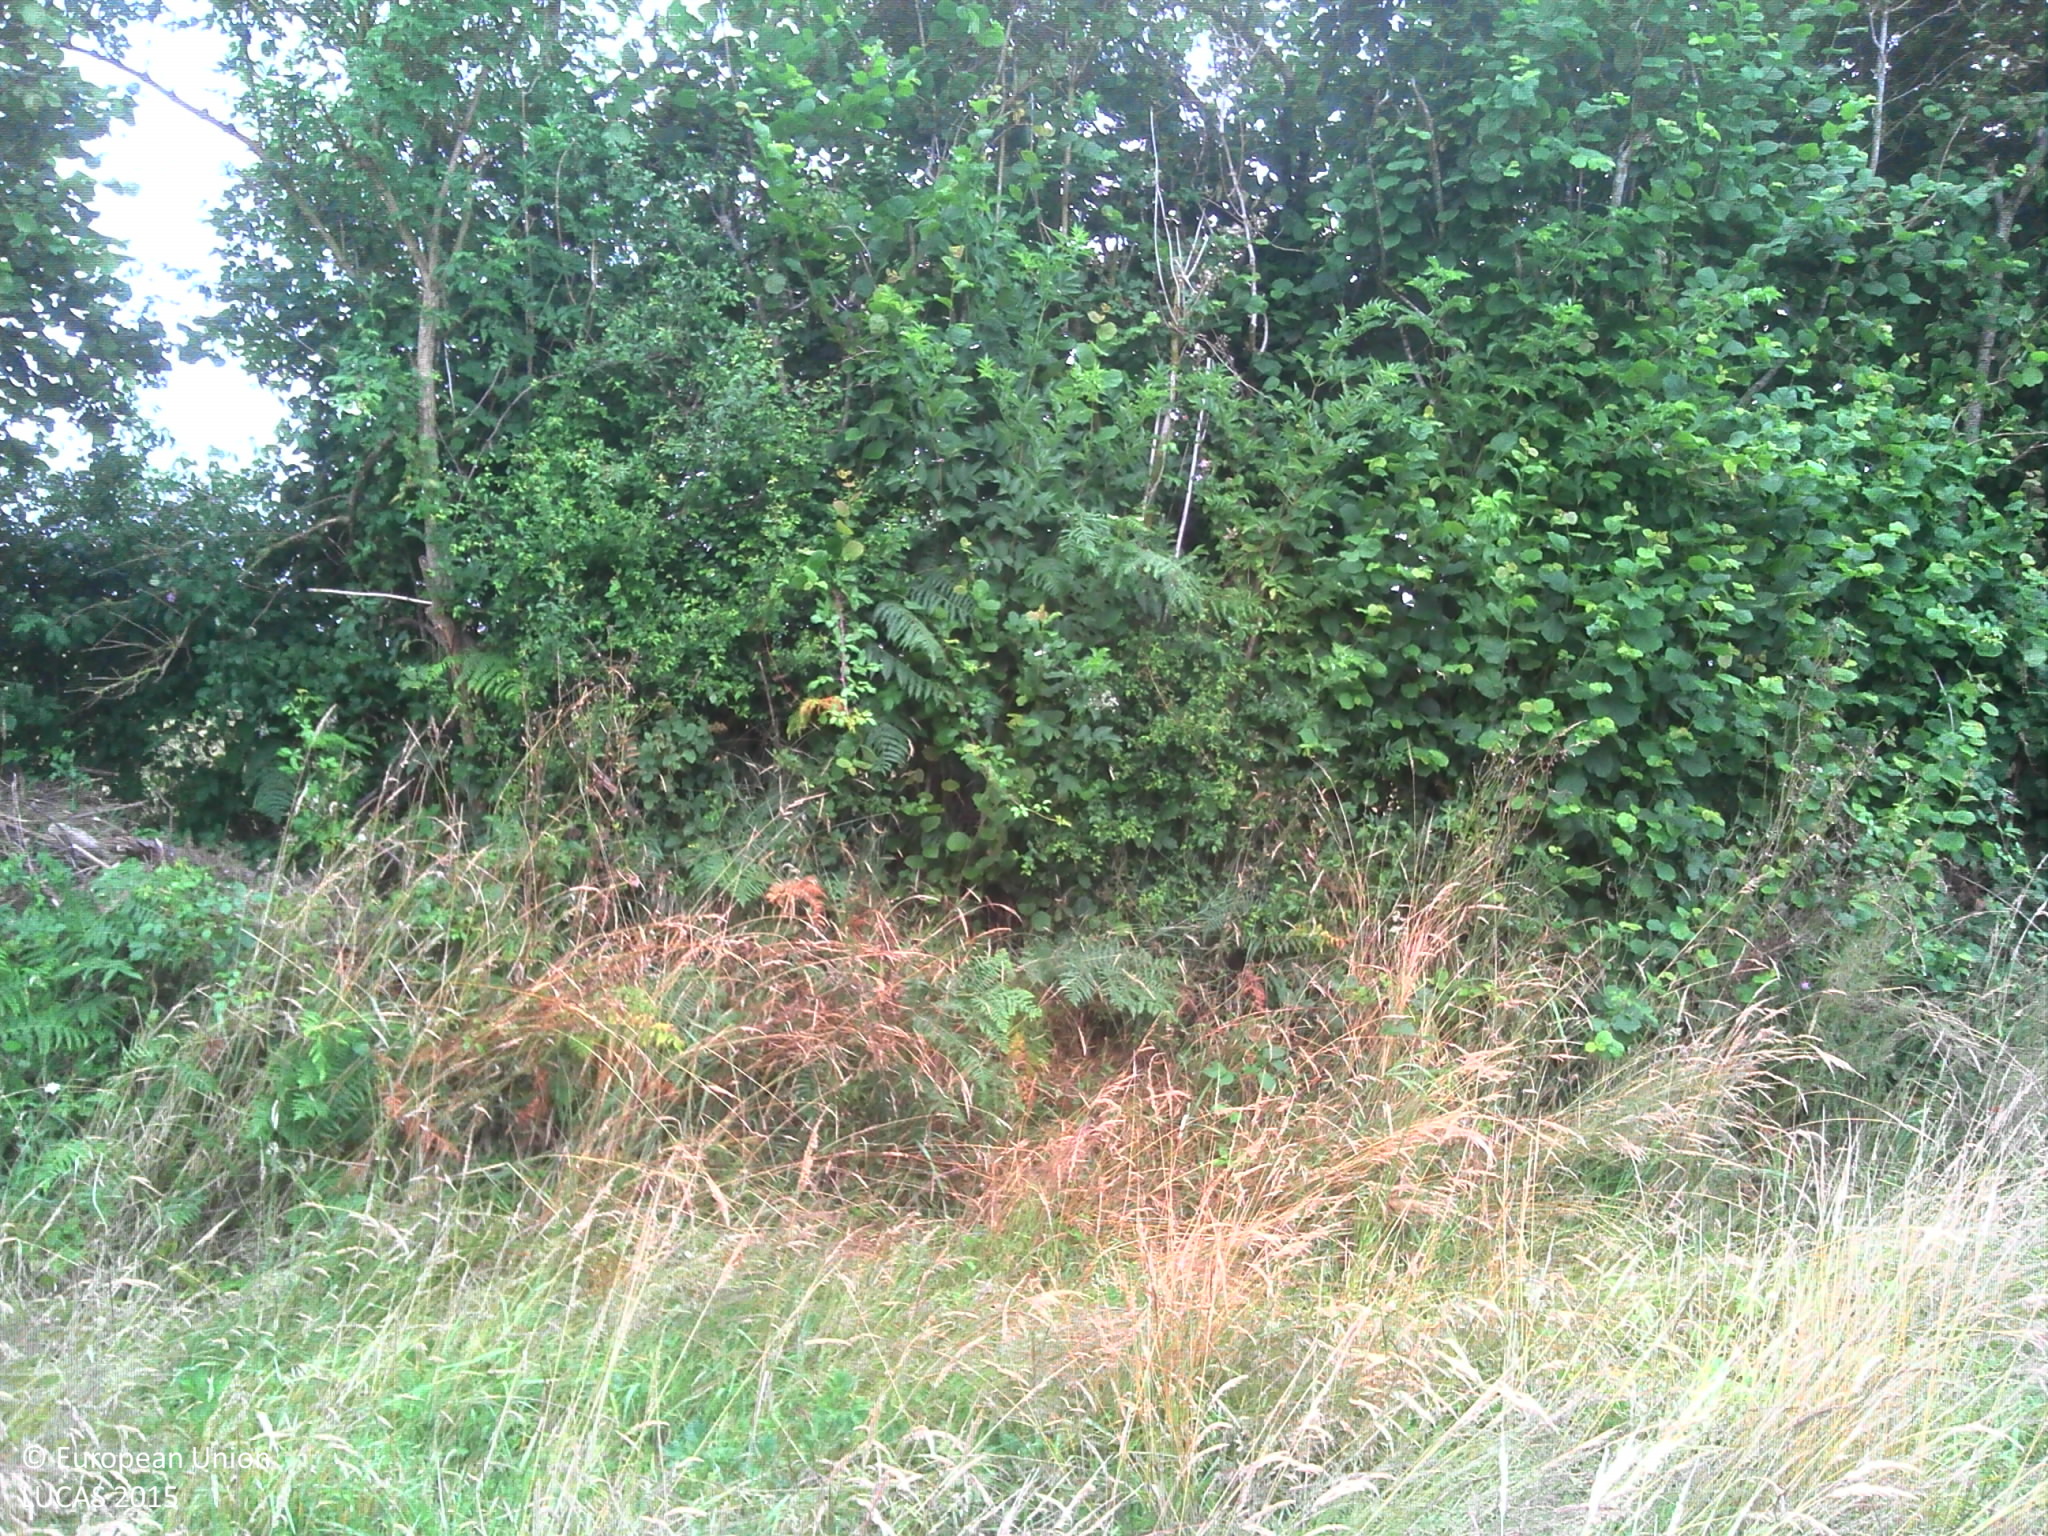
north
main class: Grassland
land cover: Grassland without tree/shrub cover
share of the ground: > 75 %
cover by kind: herbaceous plants 100 %
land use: Agriculture (excluding fallow land and kitchen gardens)
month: July
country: FR
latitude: 46.5385
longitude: -1.5789
